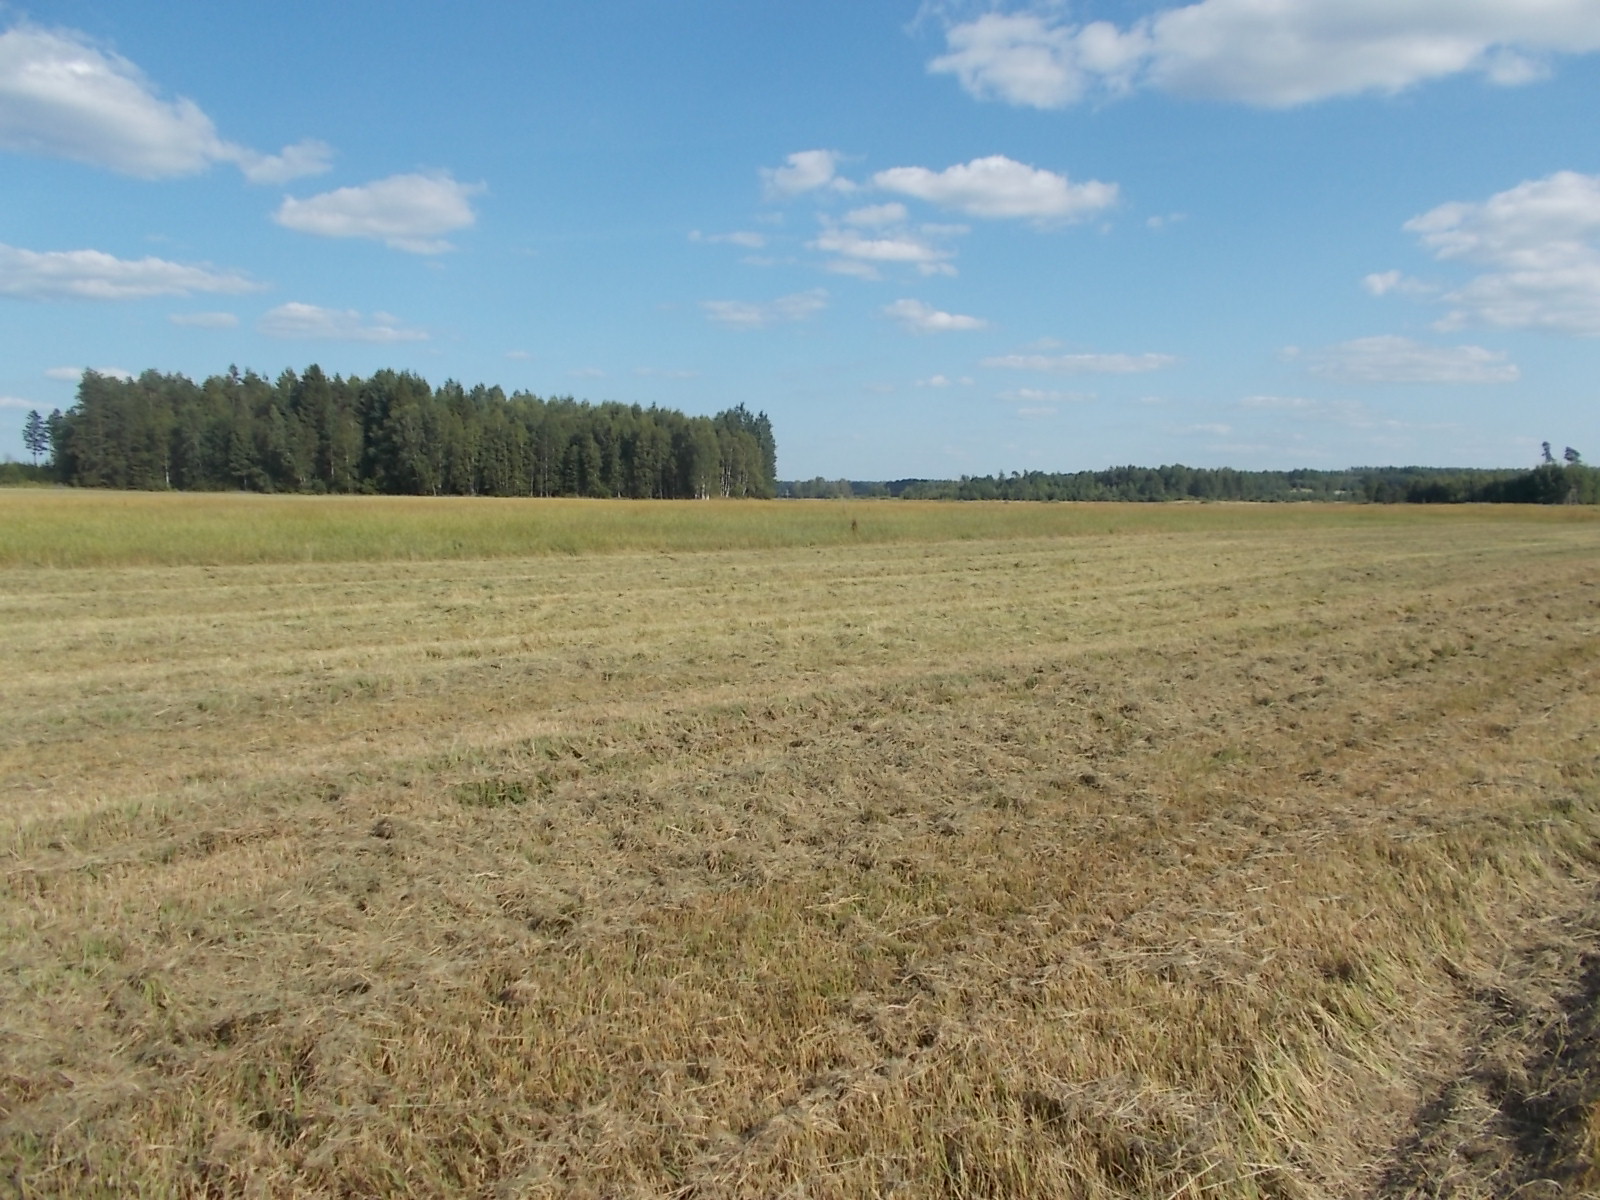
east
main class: Grassland
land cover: Grassland without tree/shrub cover
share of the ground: > 75 %
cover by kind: herbaceous plants 100 %
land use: Agriculture (excluding fallow land and kitchen gardens)
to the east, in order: Grassland without tree/shrub cover
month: August
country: LV
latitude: 57.0662
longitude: 21.7360
